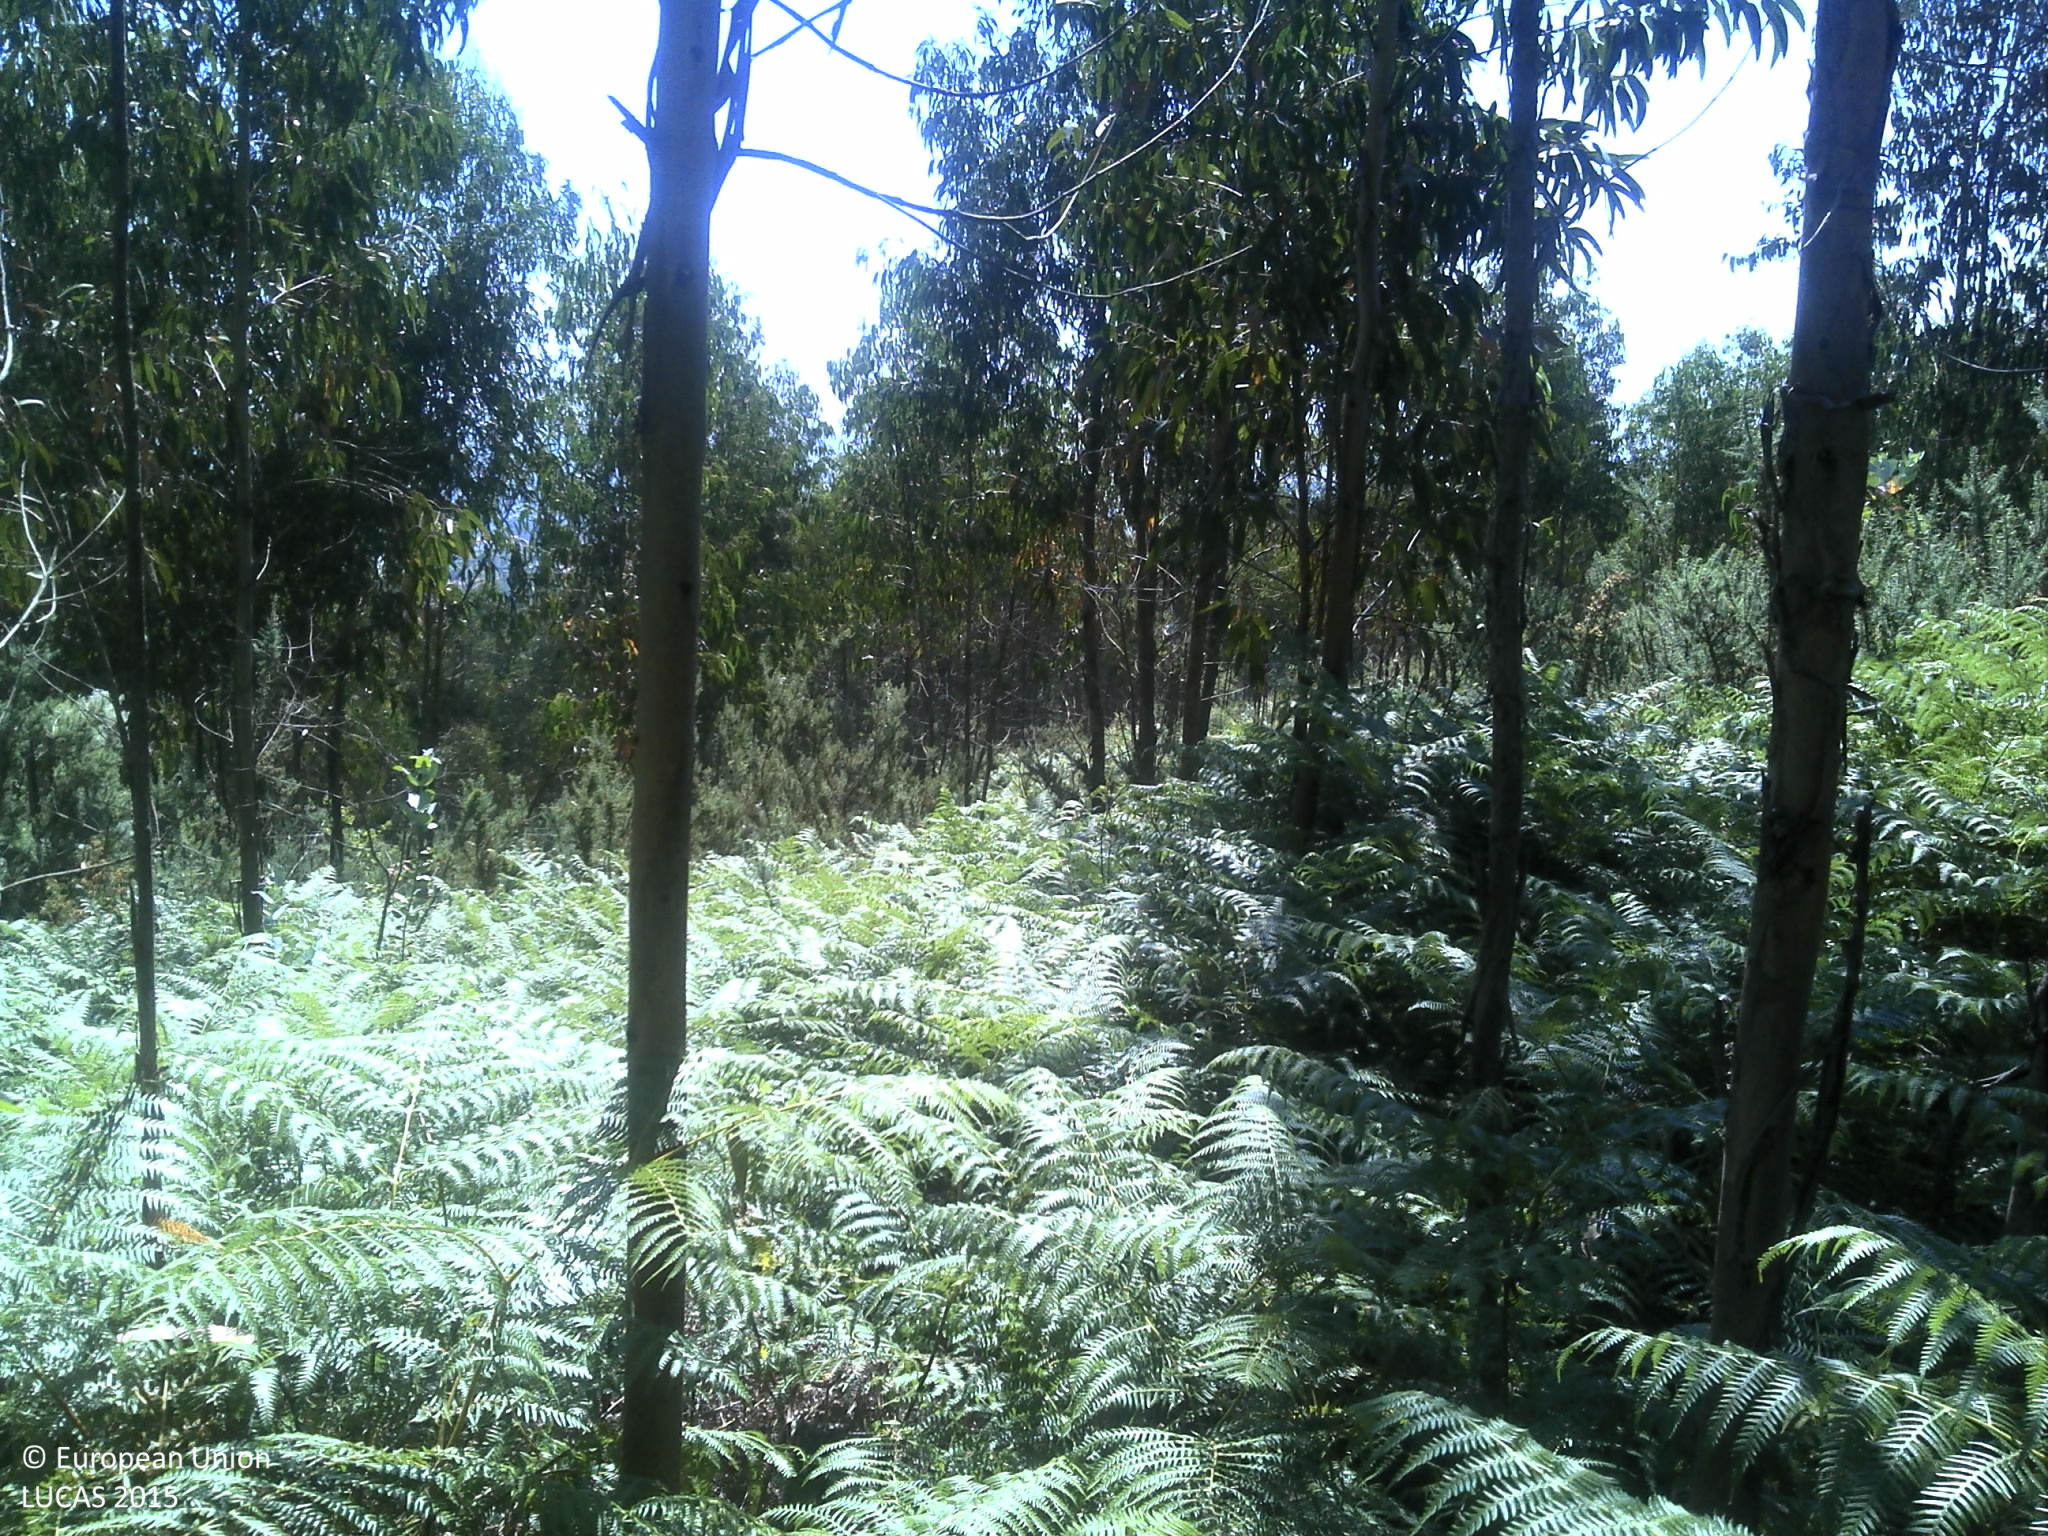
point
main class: Woodland
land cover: Broadleaved woodland
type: exotic forest
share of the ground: 25 - 50 %
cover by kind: broadleaved forest trees 50 %, shrubs 35 %, unconsolidated bare surface 10 %, herbaceous plants 5 %
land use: Forestry
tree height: > 5 m
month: June
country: PT
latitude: 41.3349
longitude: -8.1251
